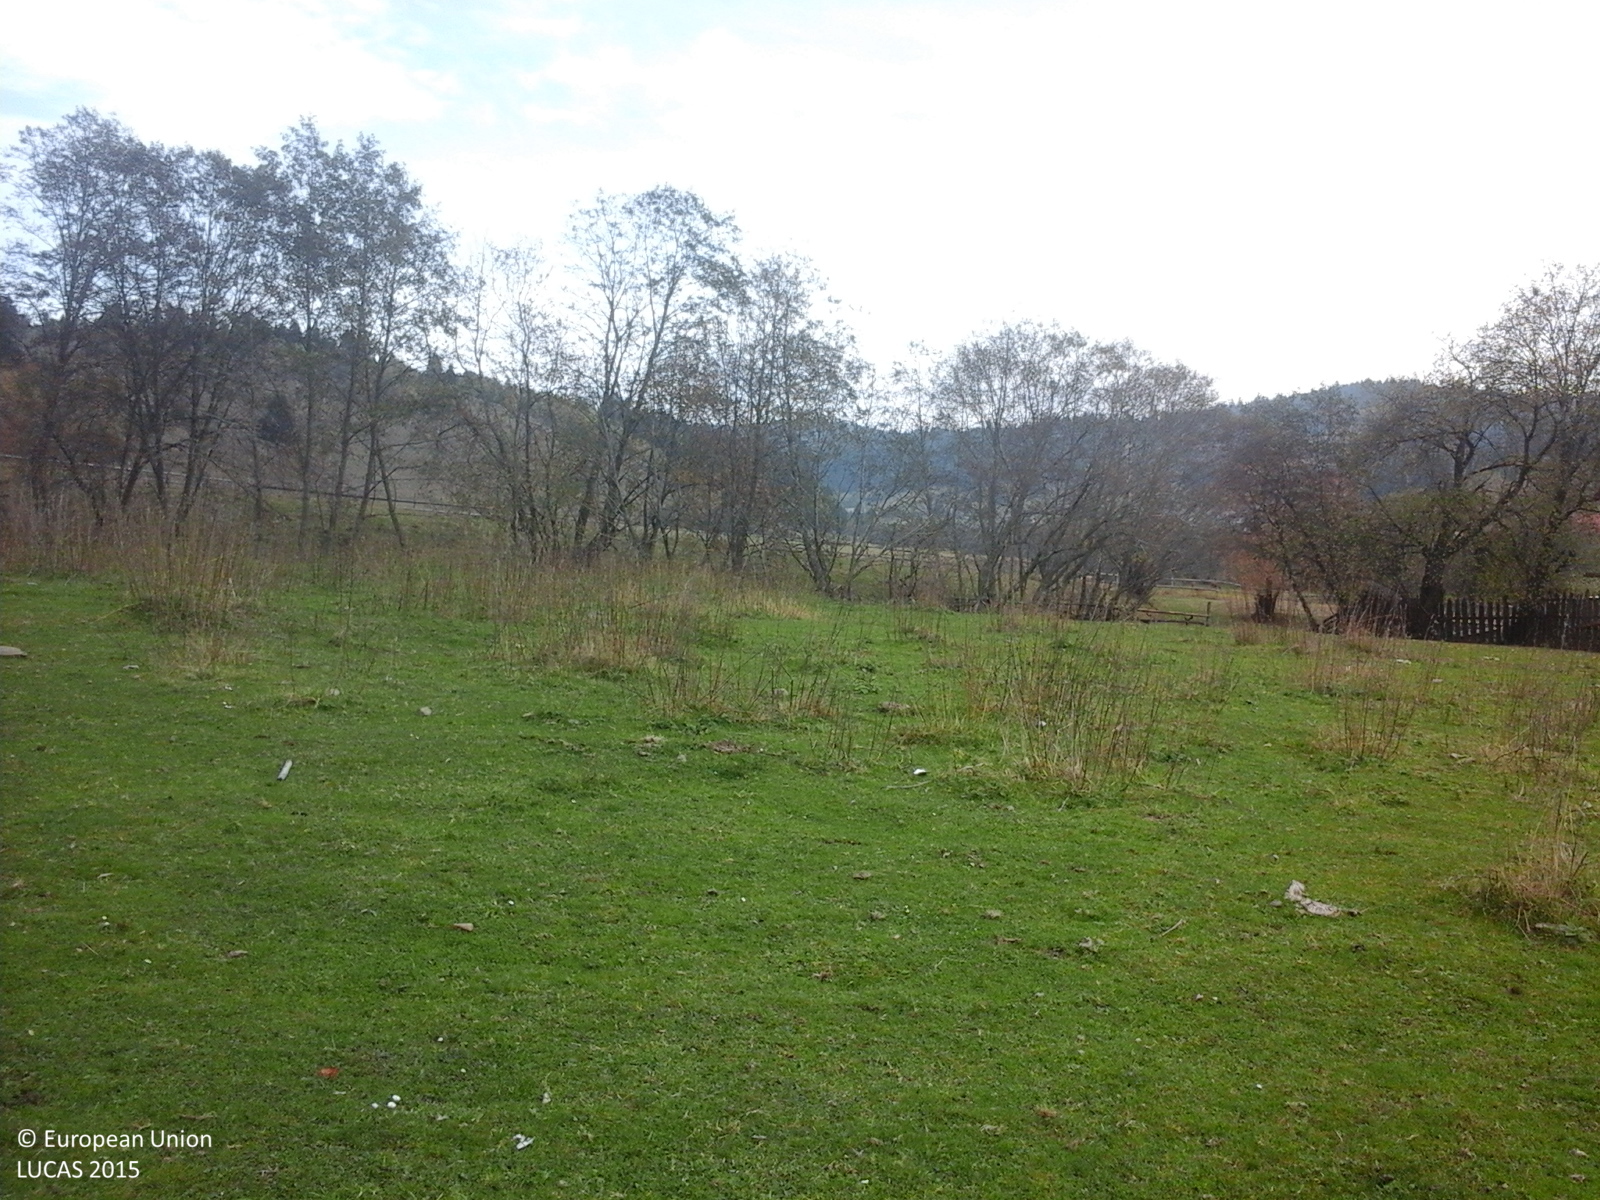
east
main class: Grassland
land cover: Grassland without tree/shrub cover
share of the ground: > 75 %
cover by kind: herbaceous plants 100 %
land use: Agriculture (excluding fallow land and kitchen gardens)
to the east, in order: Grassland without tree/shrub cover; Abandoned hedges; Ditches and canals; Abandoned hedges; Grassland without tree/shrub cover; Single bushes/trees; Electric lines; Grassland without tree/shrub cover; Tracks; Grass margins; Fences; Grassland without tree/shrub cover; Spontaneously vegetated surfaces; Fences; Shrubland with sparse tree cover
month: October
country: RO
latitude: 46.3033
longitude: 26.0516
